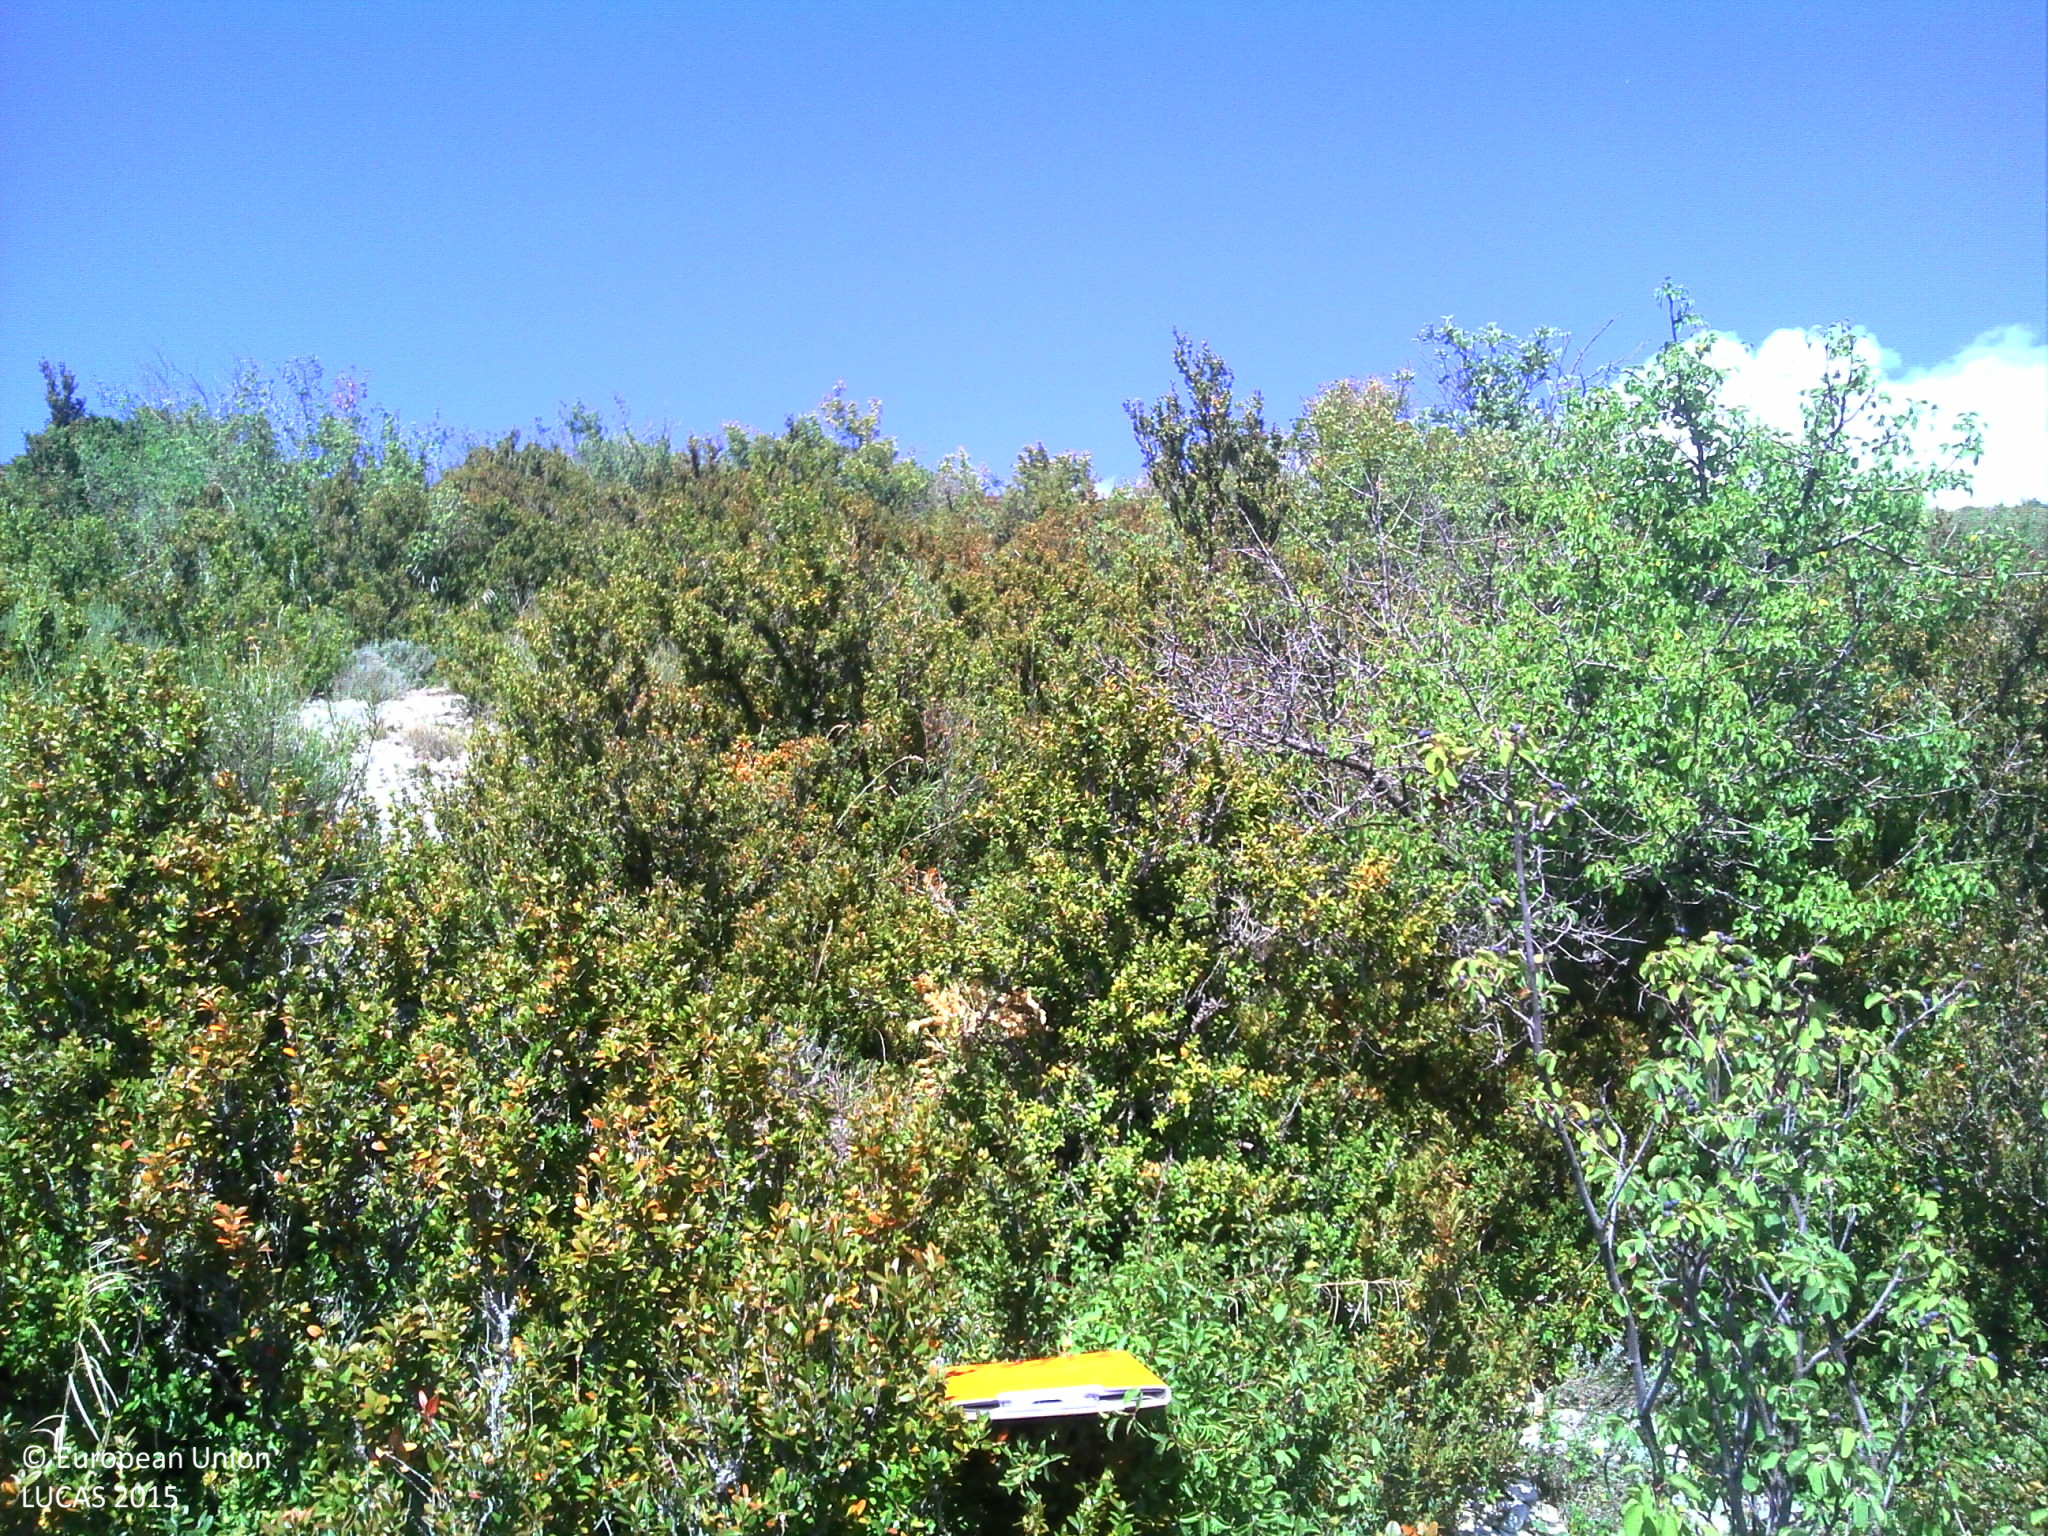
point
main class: Shrubland
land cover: Shrubland without tree cover
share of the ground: > 75 %
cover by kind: shrubs 90 %, unconsolidated bare surface 10 %
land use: Semi-natural and natural areas not in use
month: September
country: FR
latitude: 44.4594
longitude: 5.2689
